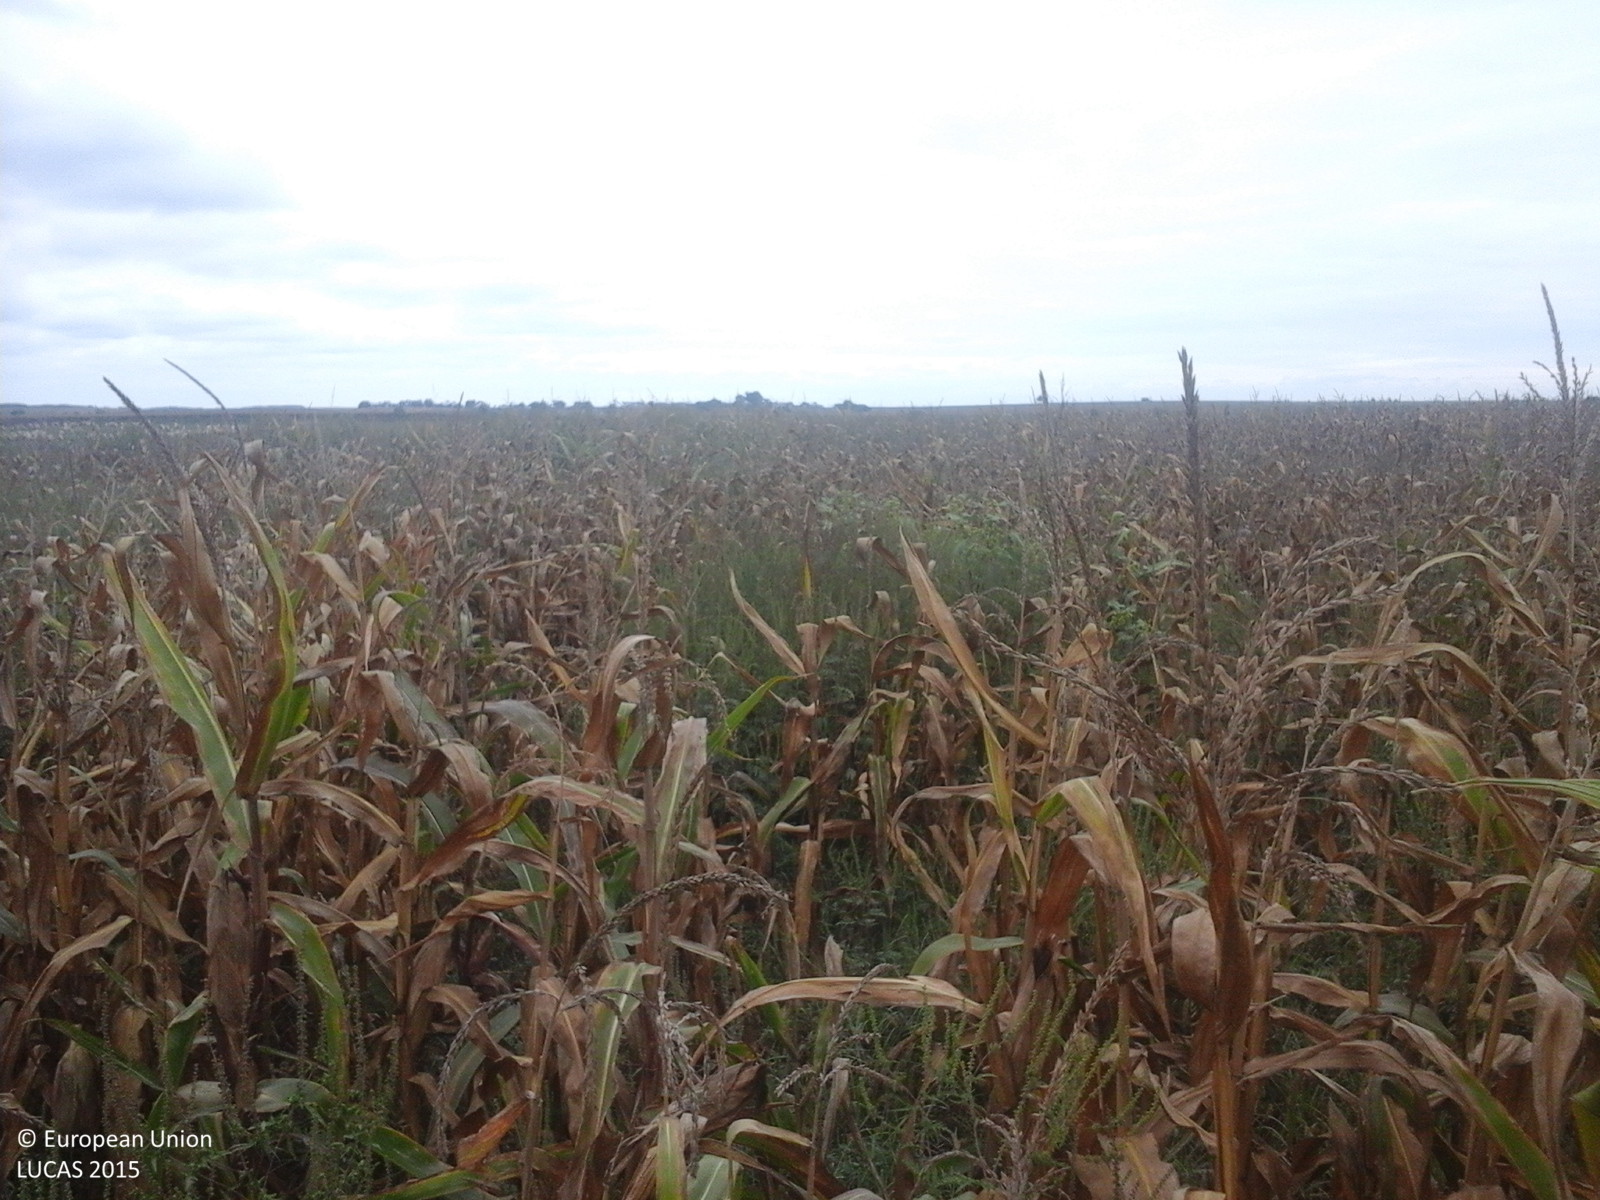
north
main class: Cropland
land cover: Maize
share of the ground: > 75 %
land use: Agriculture (excluding fallow land and kitchen gardens)
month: September
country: RO
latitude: 47.3143
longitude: 21.9673
